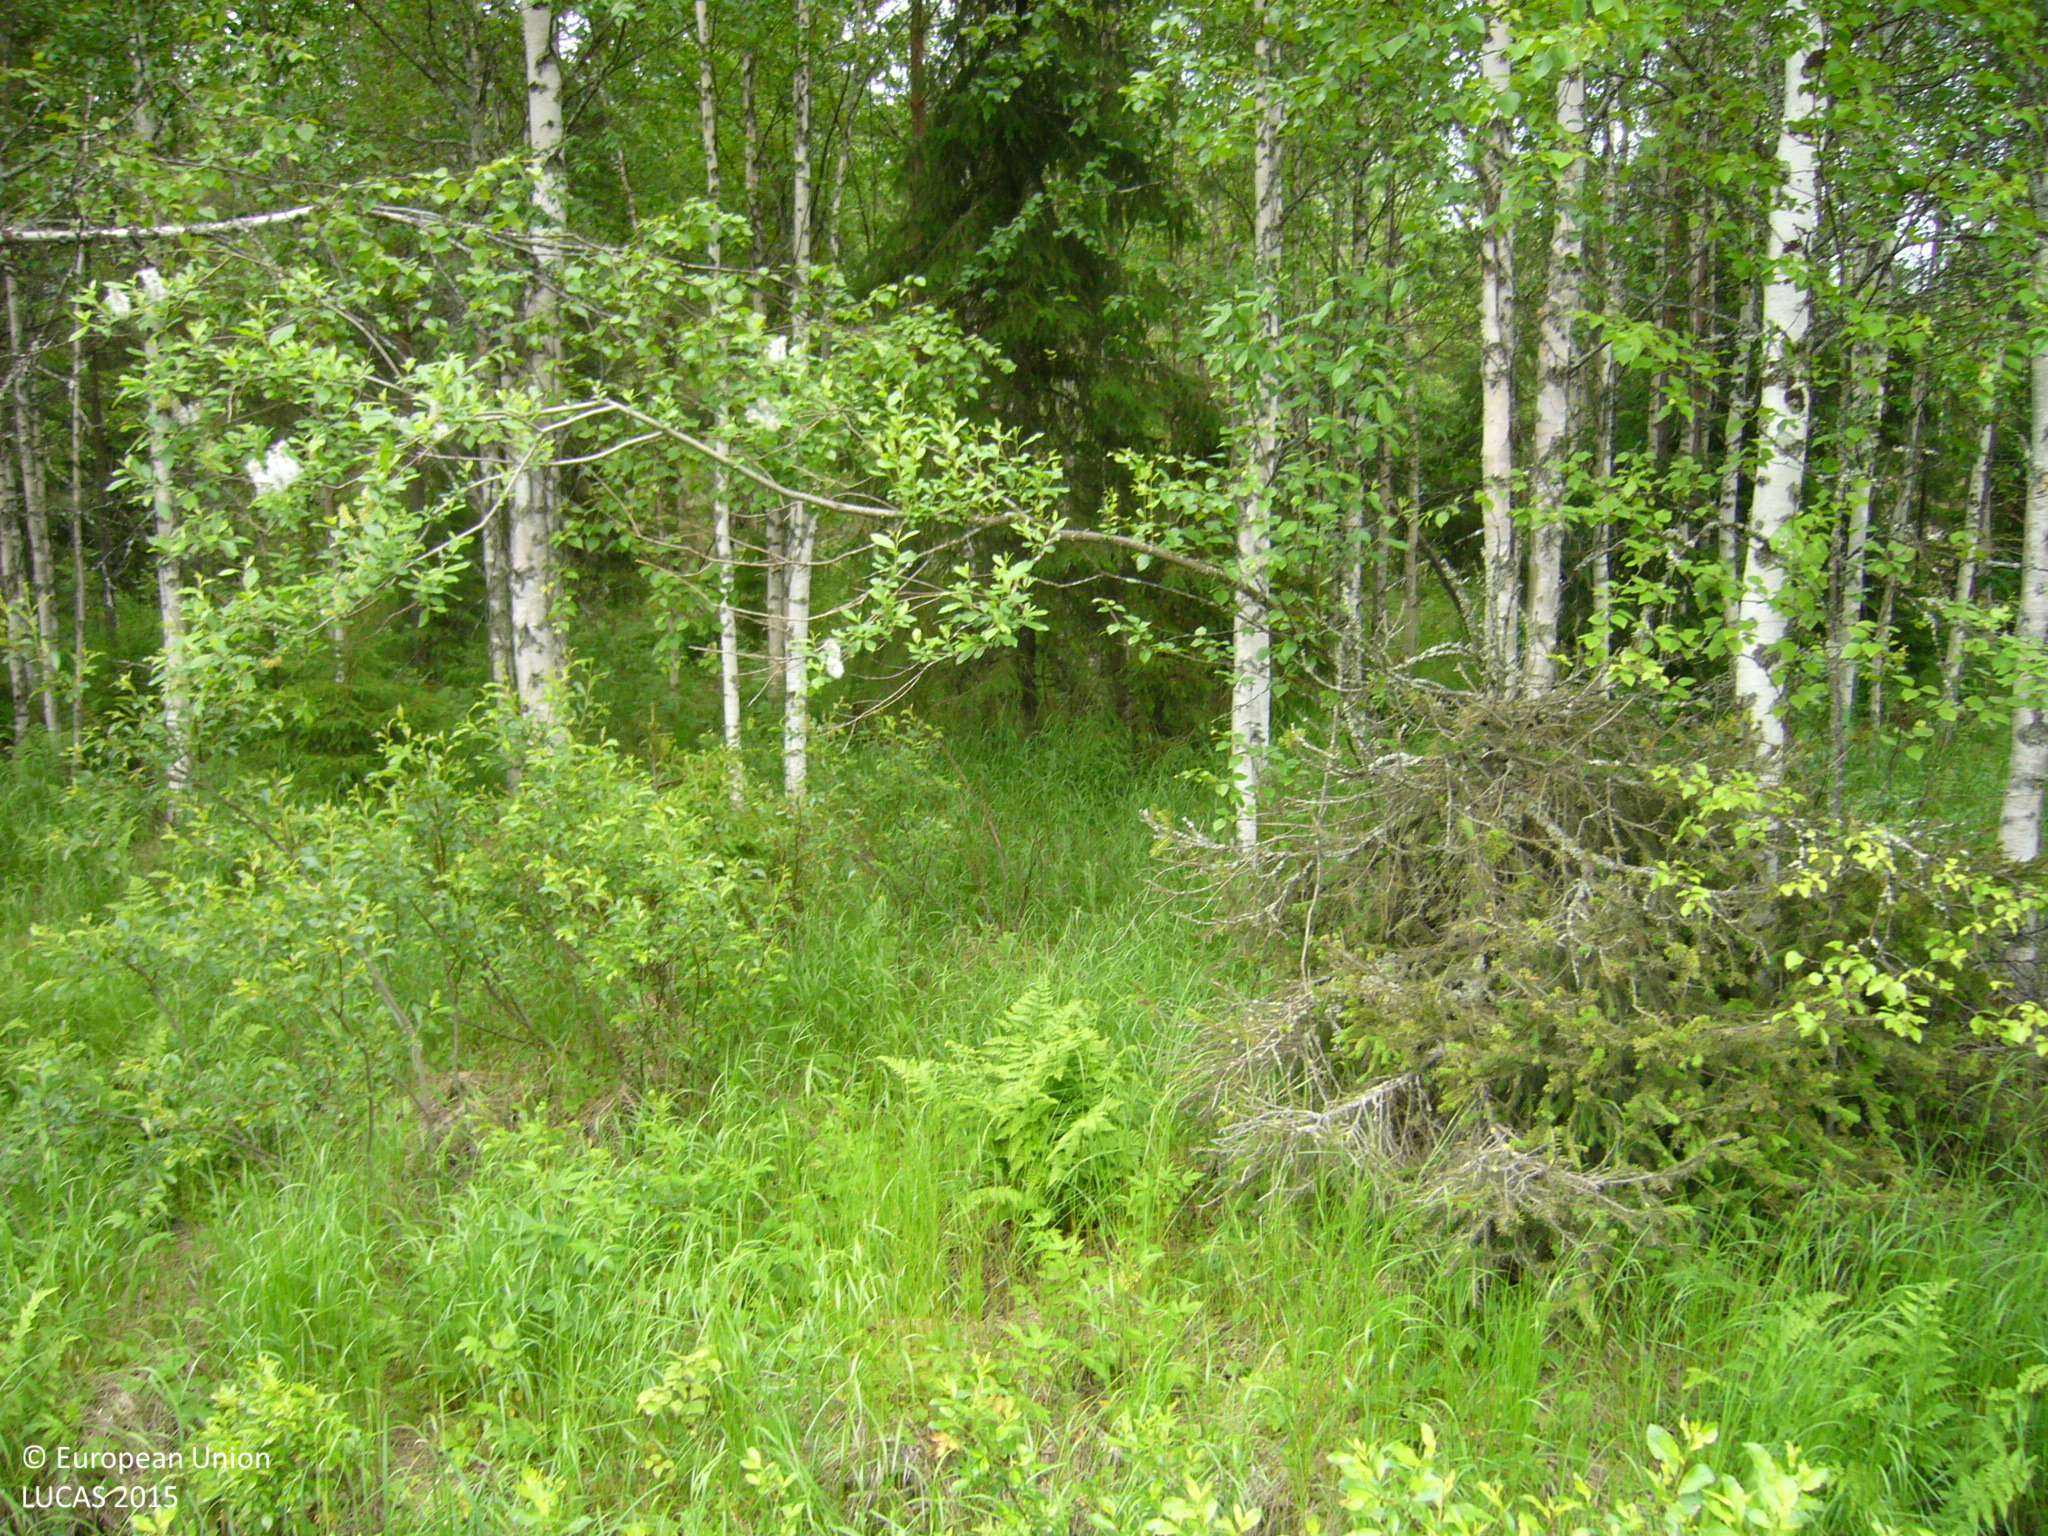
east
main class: Woodland
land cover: Other mixed woodland
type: boreal forest
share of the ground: > 75 %
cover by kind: broadleaved forest trees 50 %, coniferous forest trees 25 %, herbaceous plants 20 %, shrubs 5 %
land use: Forestry
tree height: > 5 m
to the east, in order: Other mixed woodland; Ditches and canals; Other mixed woodland; Spruce dominated mixed woodland; Pine dominated mixed woodland; Tracks; Ditches and canals; Spruce dominated mixed woodland; Pine dominated mixed woodland; Ditches and canals; Pine dominated mixed woodland; Ditches and canals; Pine dominated mixed woodland
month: July
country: FI
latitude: 63.4714
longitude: 26.4817
